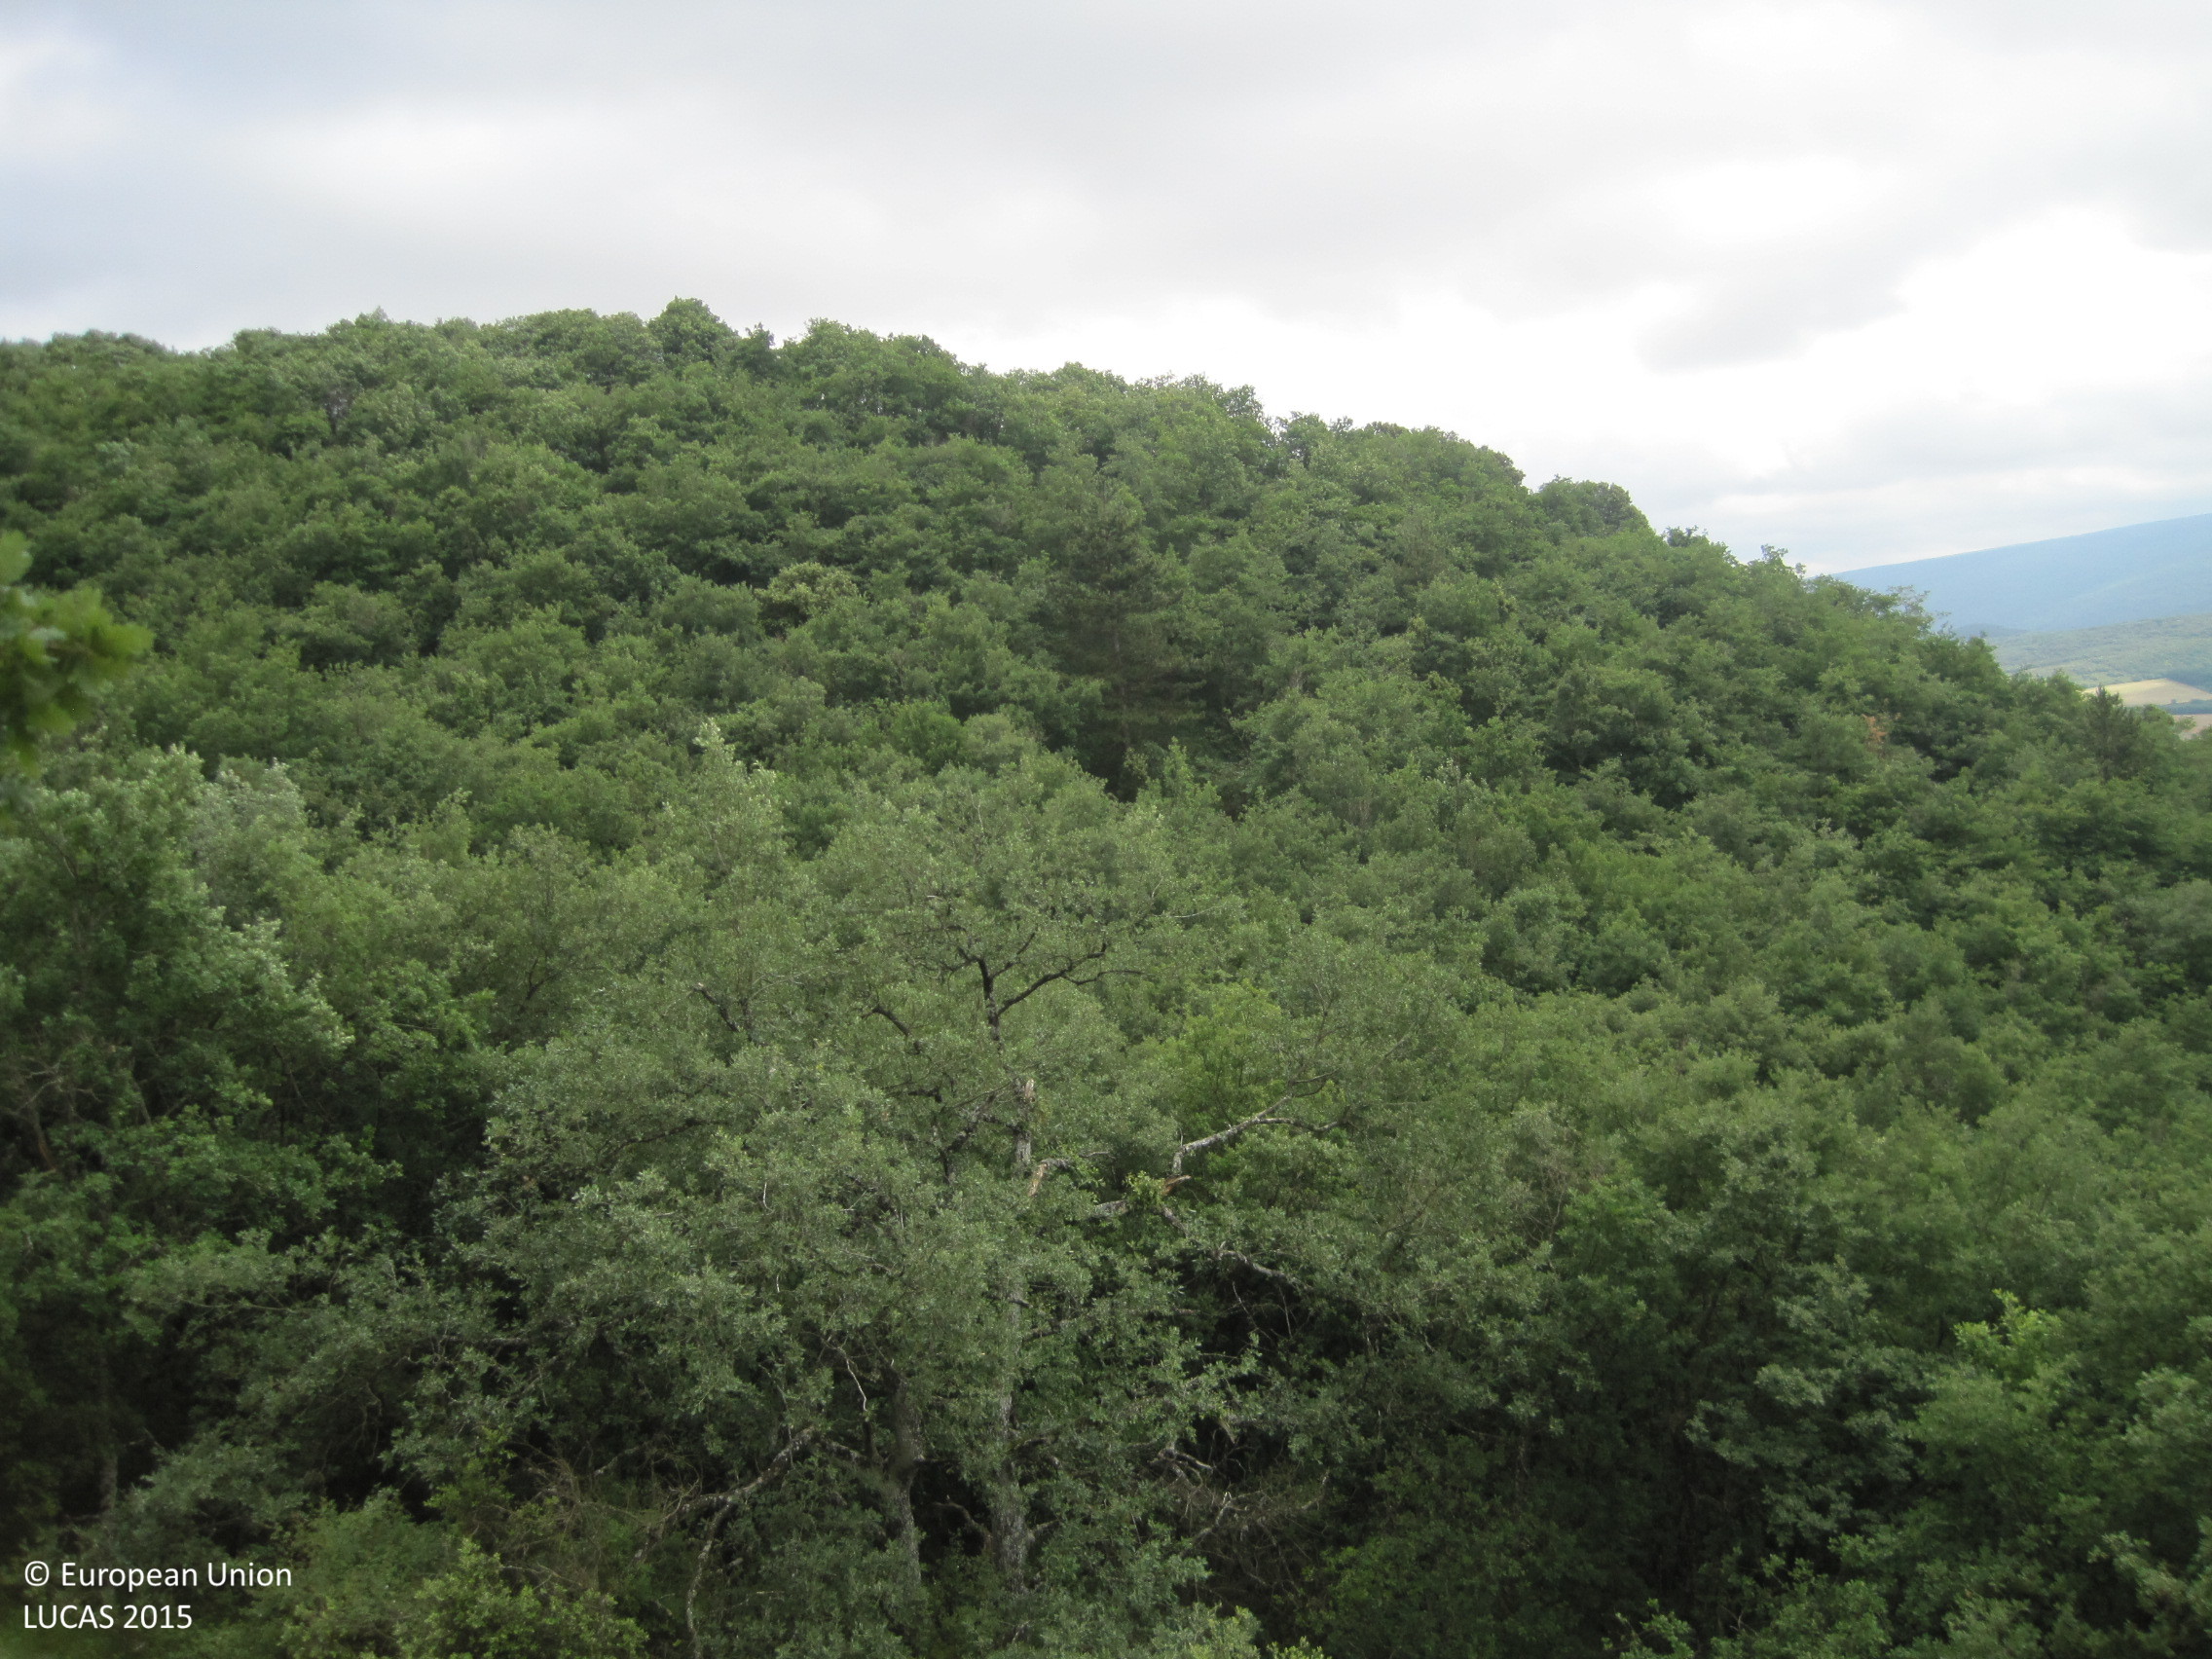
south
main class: Grassland
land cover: Grassland with sparse tree/shrub cover
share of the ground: > 75 %
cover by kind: herbaceous plants 95 %, broadleaved forest trees 5 %
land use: Agriculture (excluding fallow land and kitchen gardens)
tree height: < 5 m
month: June
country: ES
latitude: 42.8960
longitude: -1.7605
